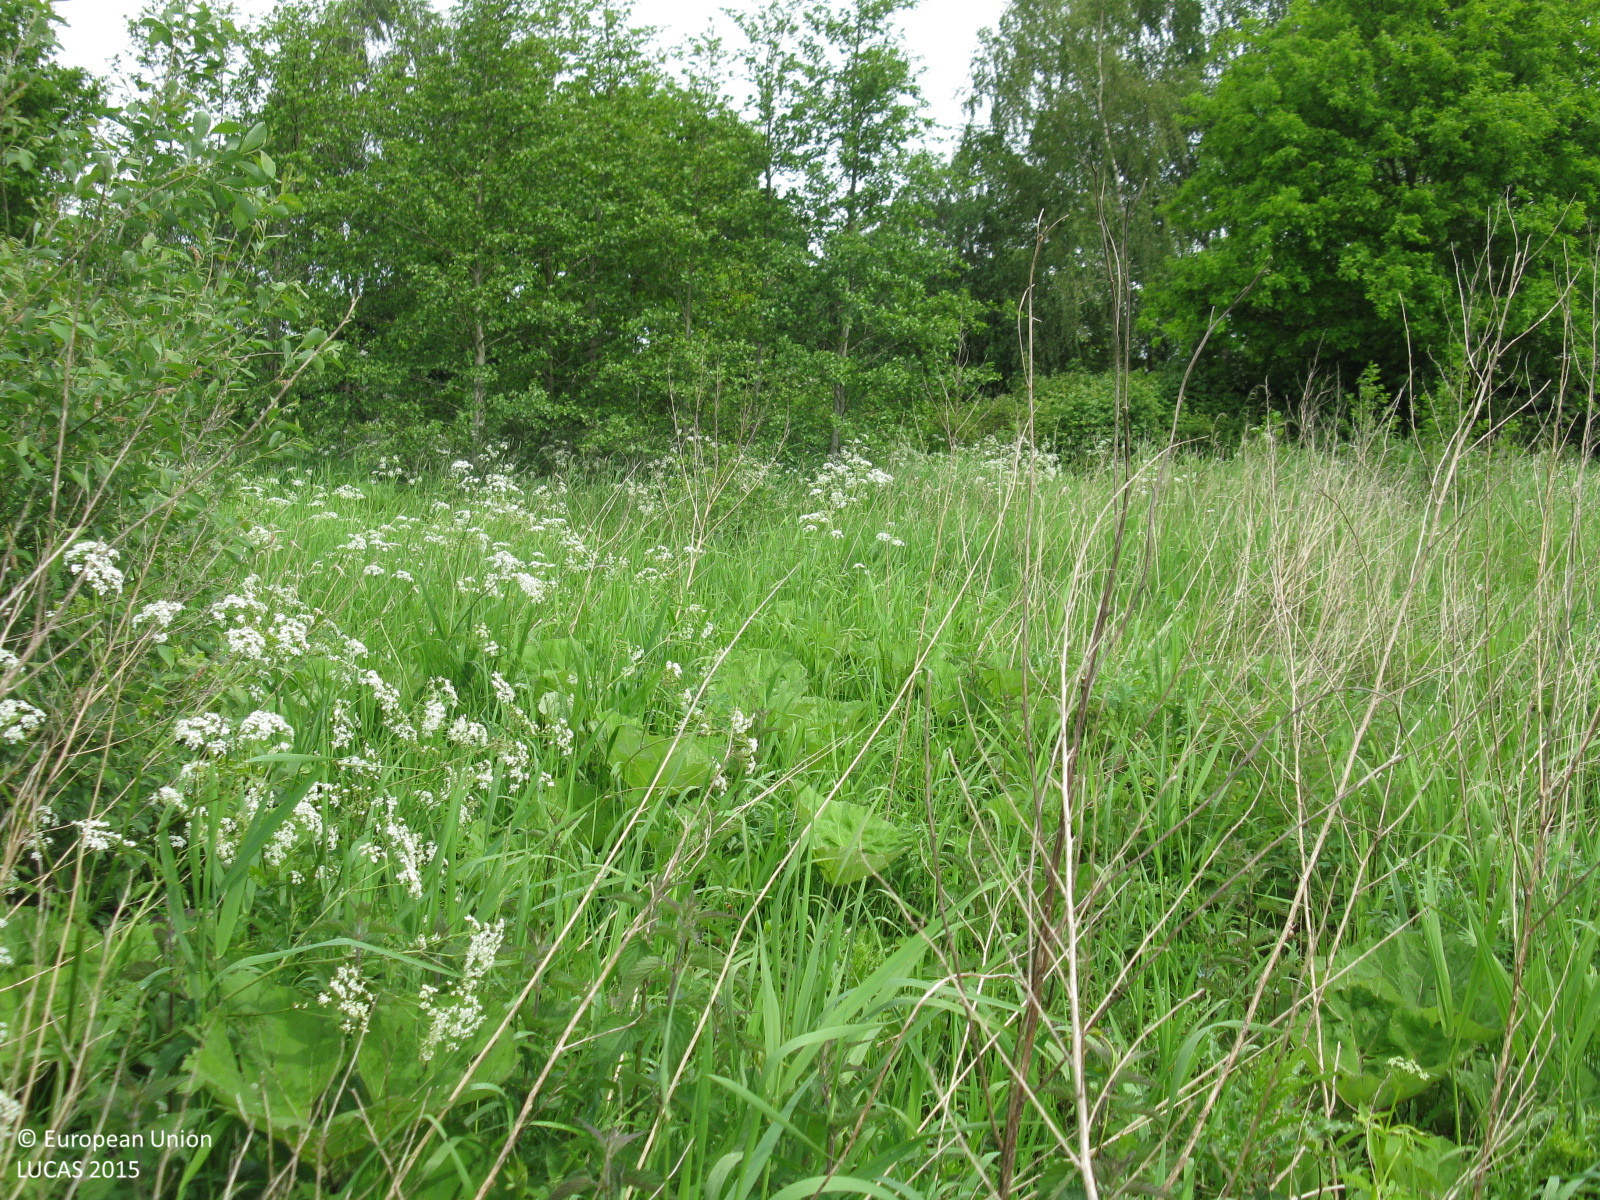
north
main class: Grassland
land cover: Grassland without tree/shrub cover
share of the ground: > 75 %
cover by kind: herbaceous plants 100 %
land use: Agriculture (excluding fallow land and kitchen gardens)
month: June
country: DE
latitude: 53.1380
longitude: 7.2949
